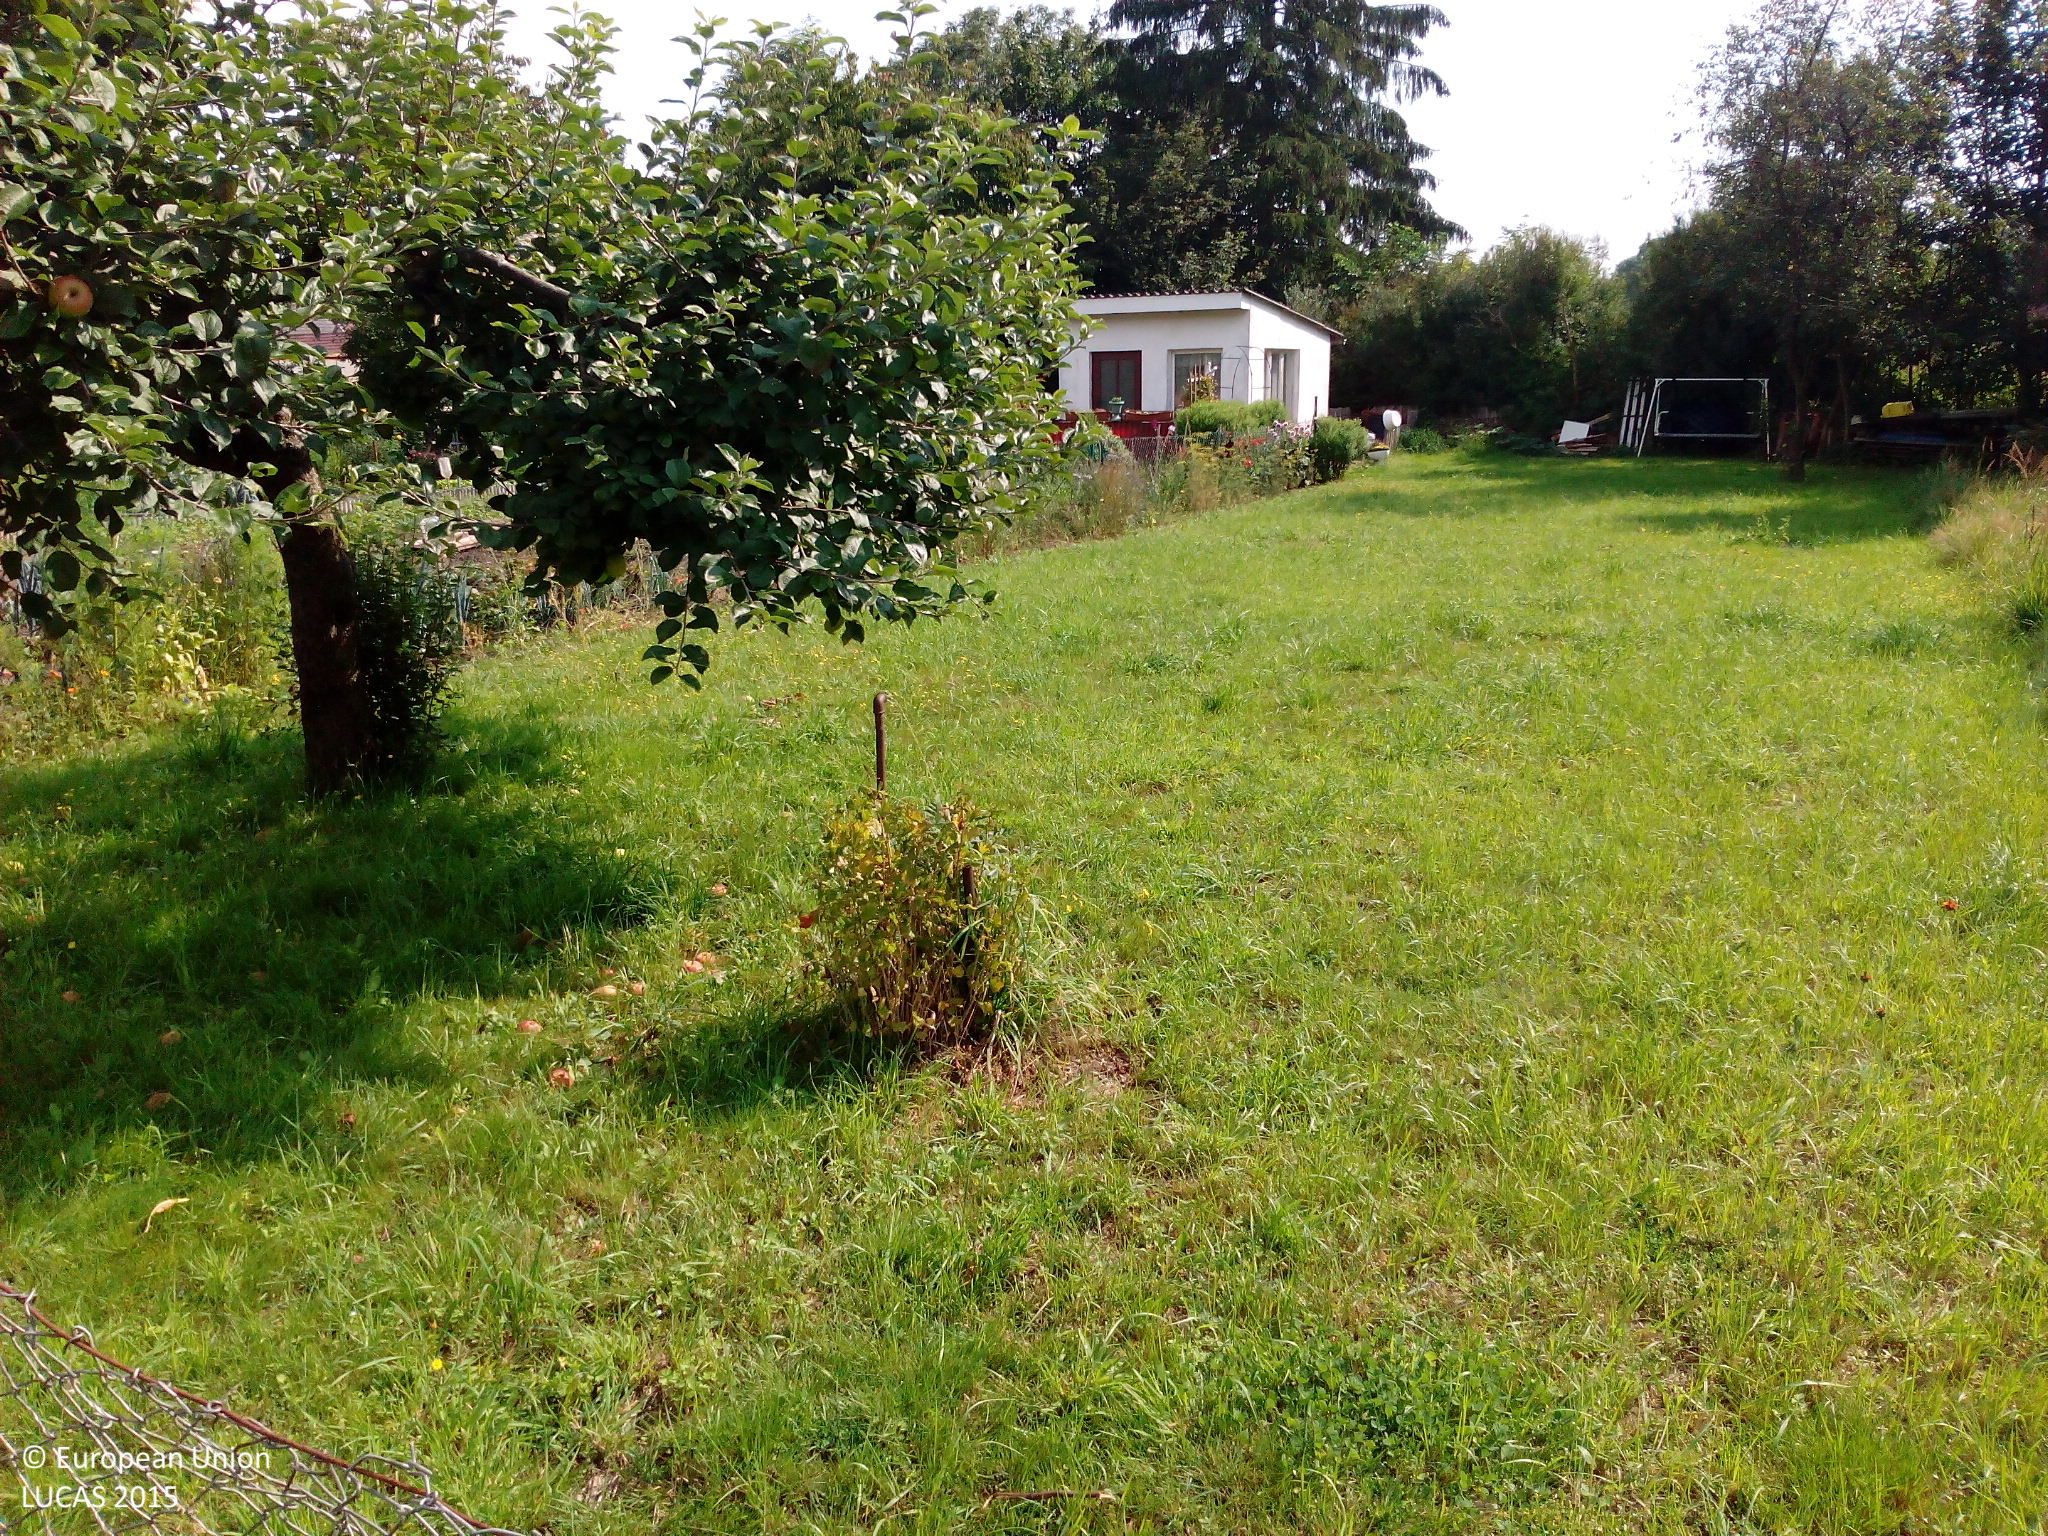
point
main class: Grassland
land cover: Grassland with sparse tree/shrub cover
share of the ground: > 75 %
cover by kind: herbaceous plants 95 %, broadleaved forest trees 5 %
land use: Residential
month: August
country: DE
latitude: 54.1822
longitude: 12.6499
